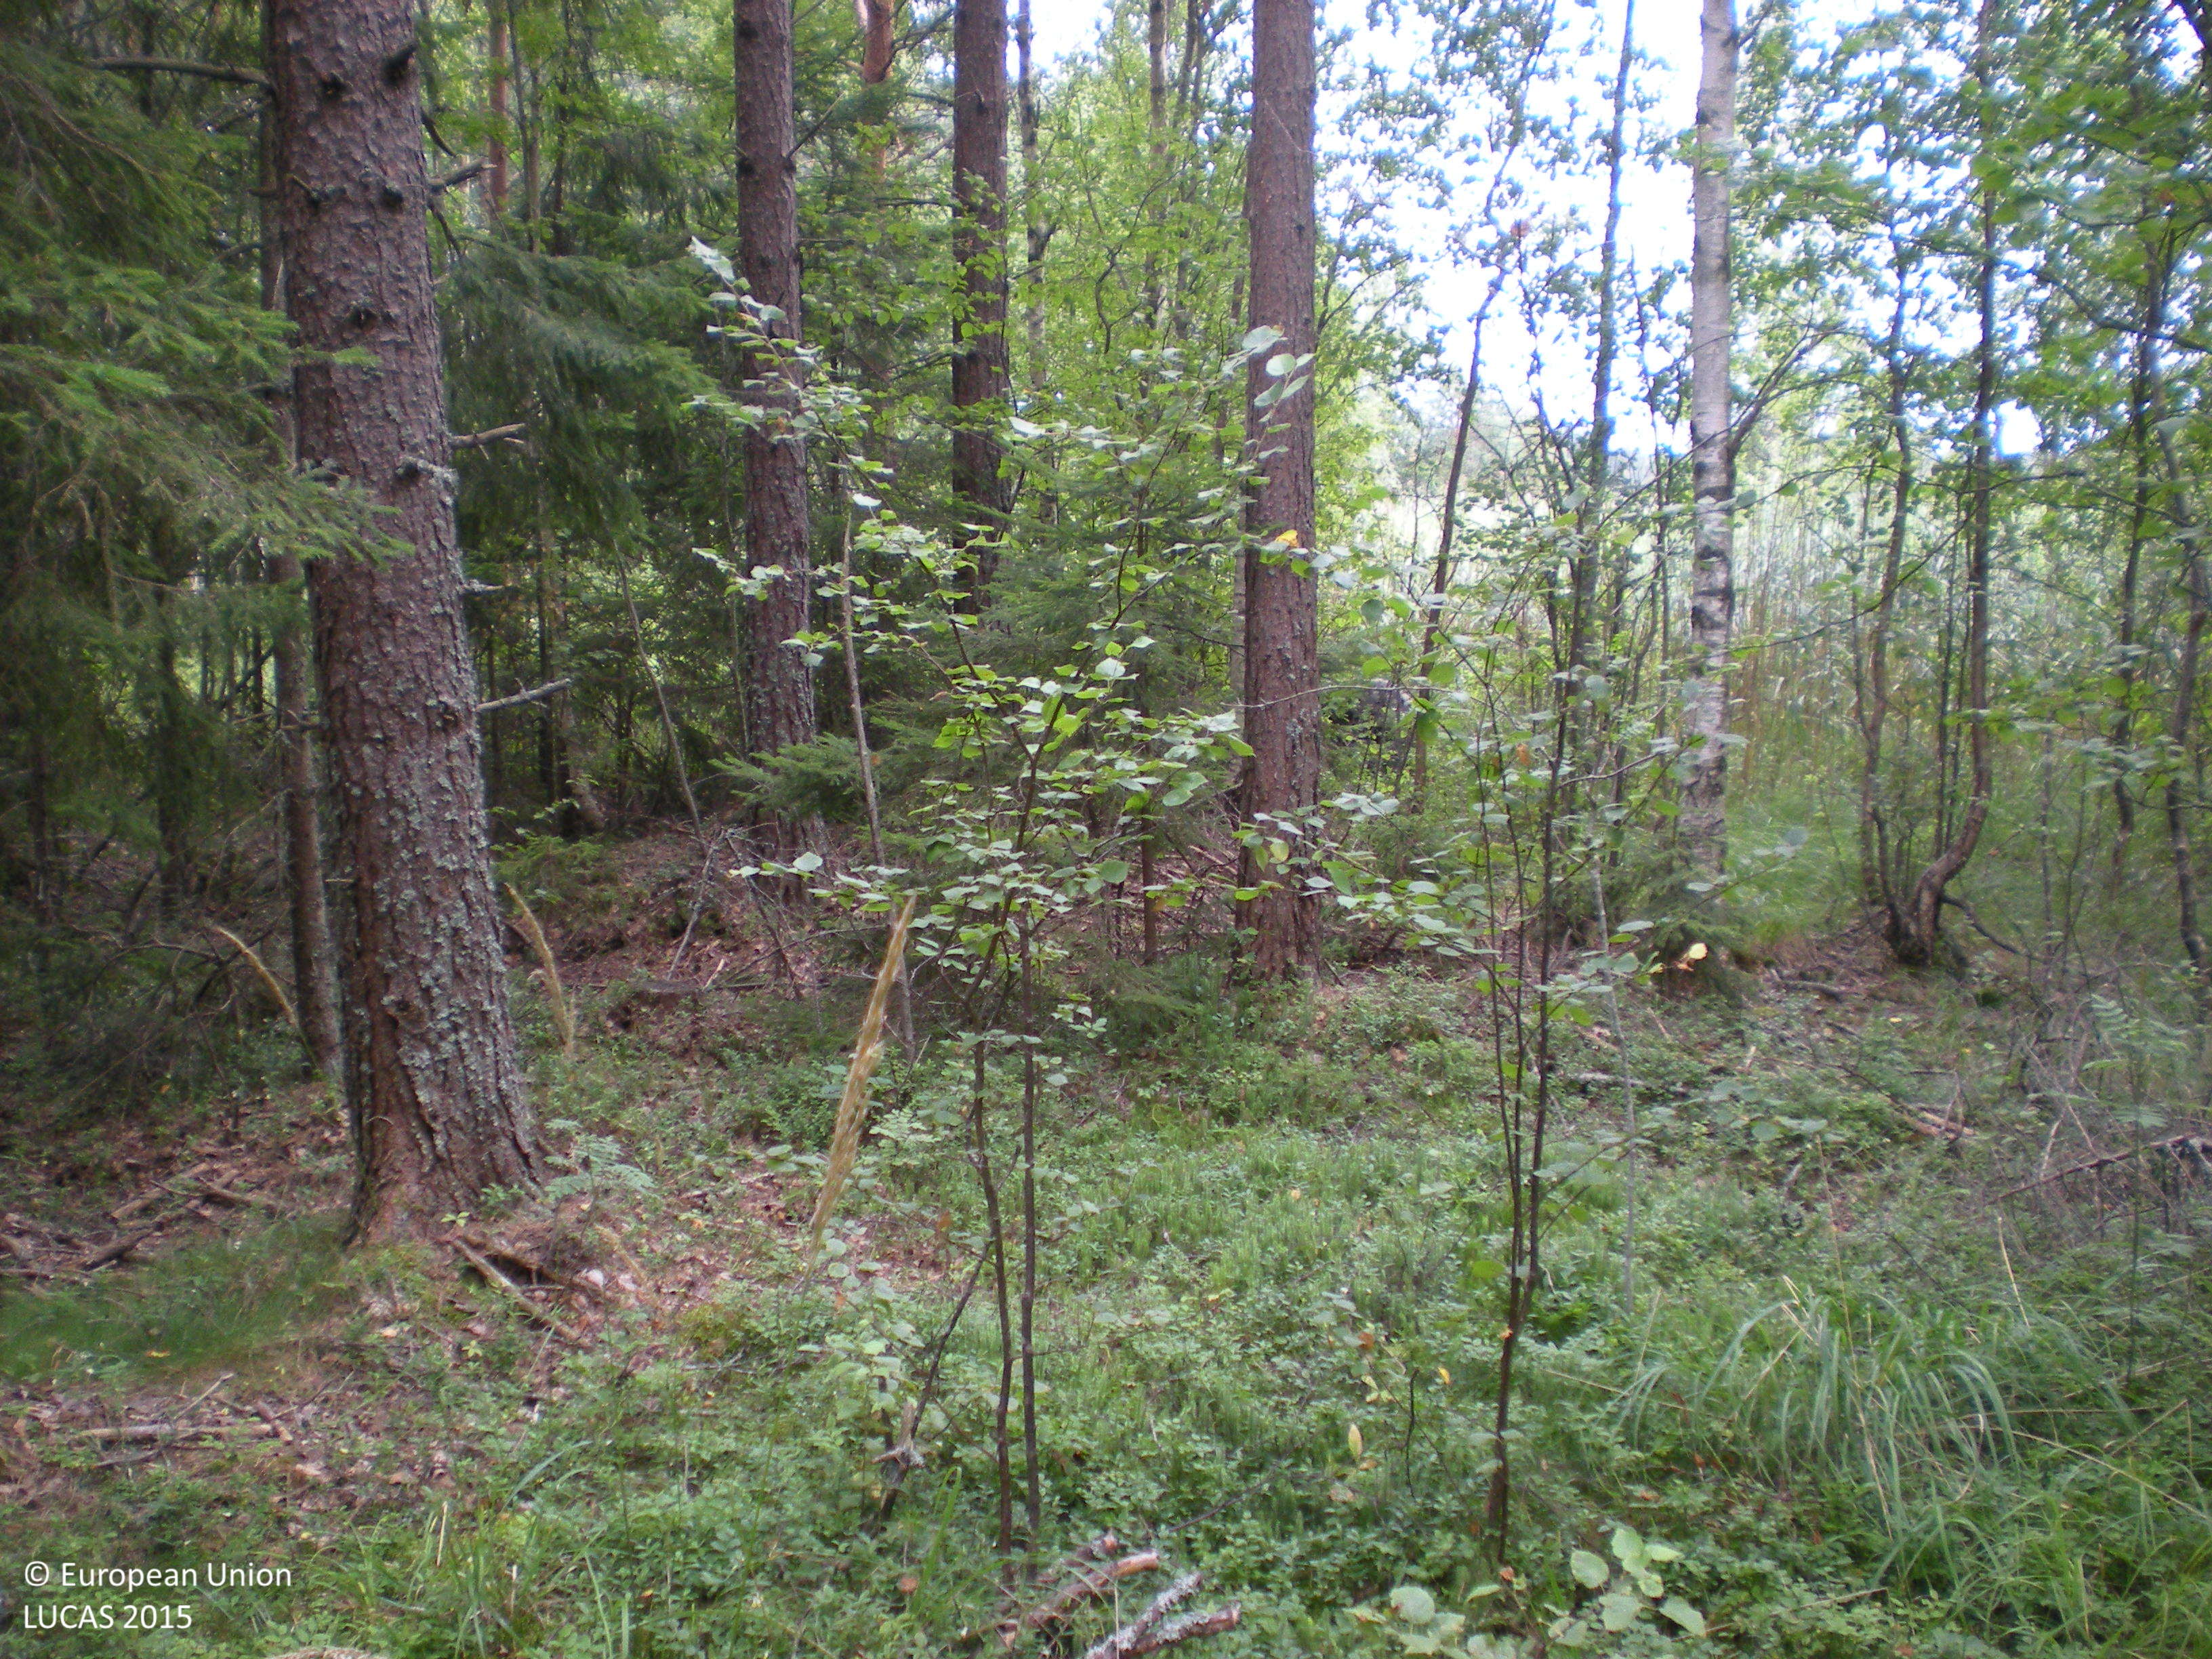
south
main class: Woodland
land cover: Pine dominated coniferous woodland
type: boreal forest
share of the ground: 50 - 75 %
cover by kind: coniferous forest trees 65 %, herbaceous plants 20 %, shrubs 10 %, lichens and mosses 5 %
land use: Forestry
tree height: > 5 m
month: August
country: SE
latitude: 60.7904
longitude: 17.2449
